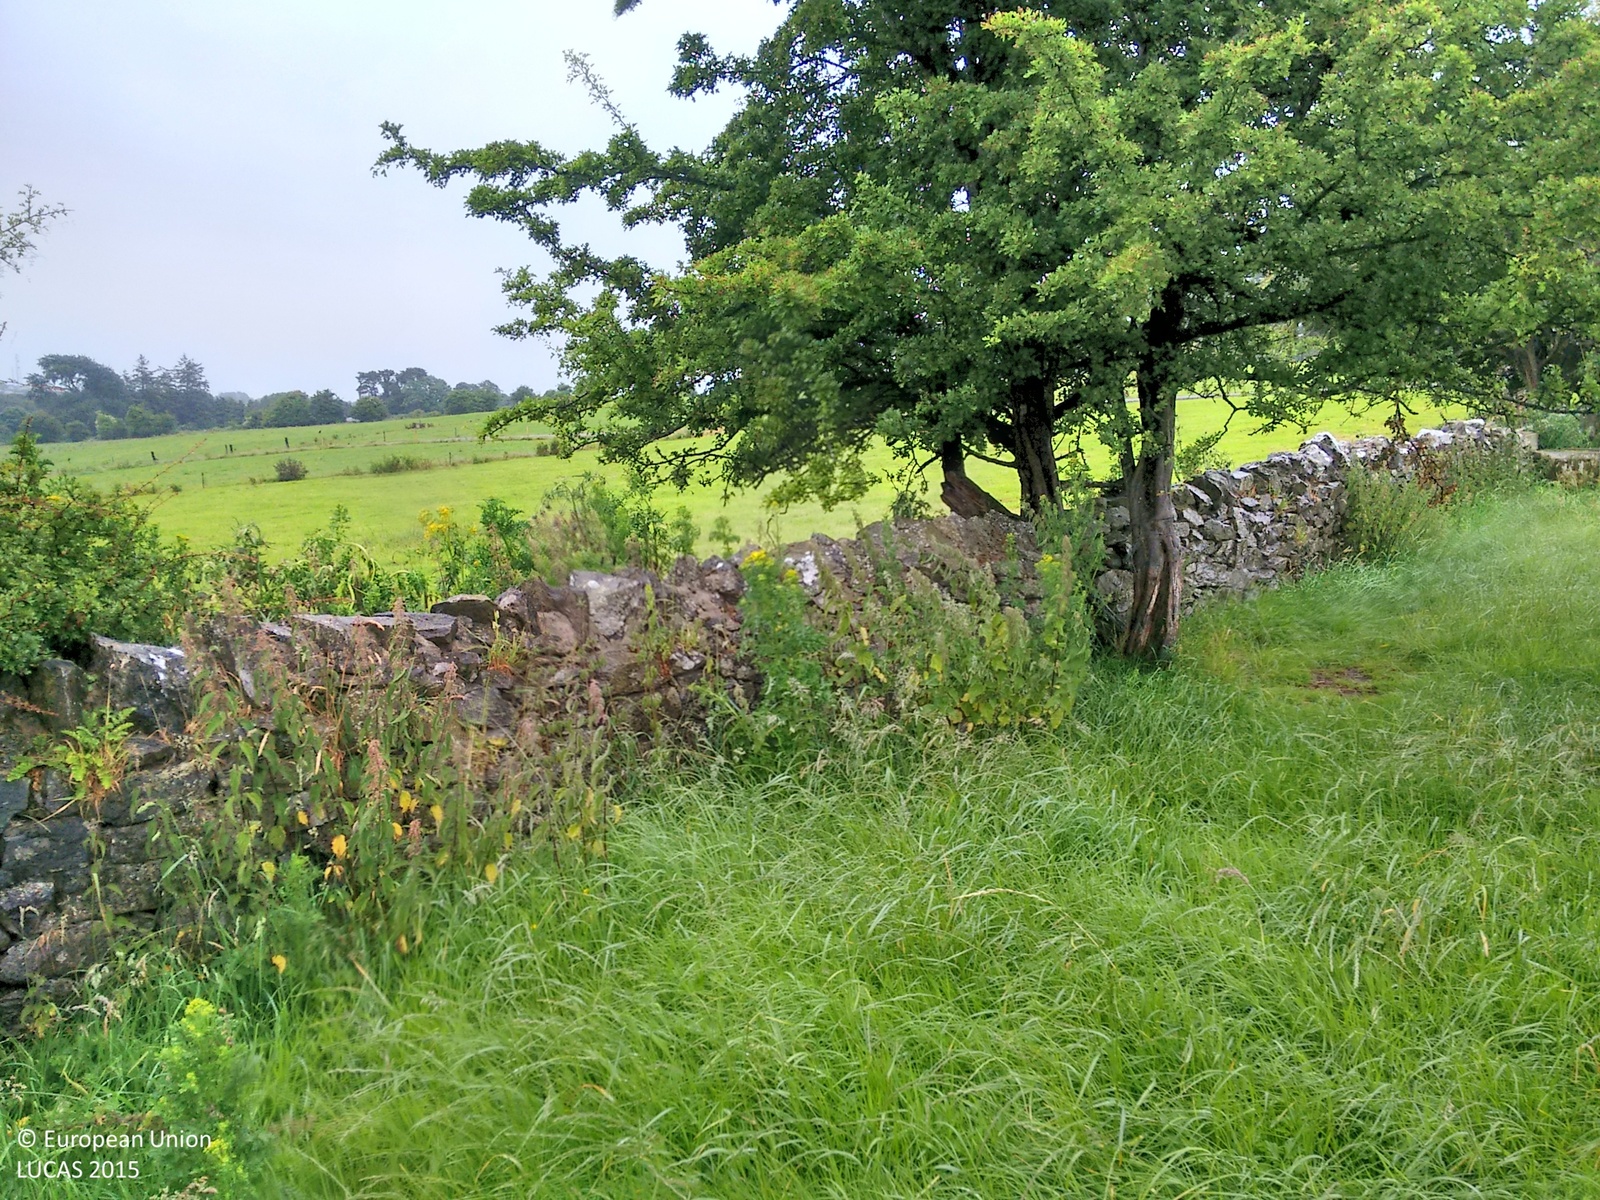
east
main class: Grassland
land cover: Grassland without tree/shrub cover
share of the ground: > 75 %
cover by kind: herbaceous plants 90 %, shrubs 5 %
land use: Agriculture (excluding fallow land and kitchen gardens)
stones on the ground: < 10 %
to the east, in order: Grassland without tree/shrub cover; Dry stone walls; Grassland without tree/shrub cover; Fences; Grassland without tree/shrub cover; Fences; Tracks; Fences; Grassland without tree/shrub cover; Fences; Grassland without tree/shrub cover
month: July
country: IE
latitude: 52.2417
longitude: -8.4547
